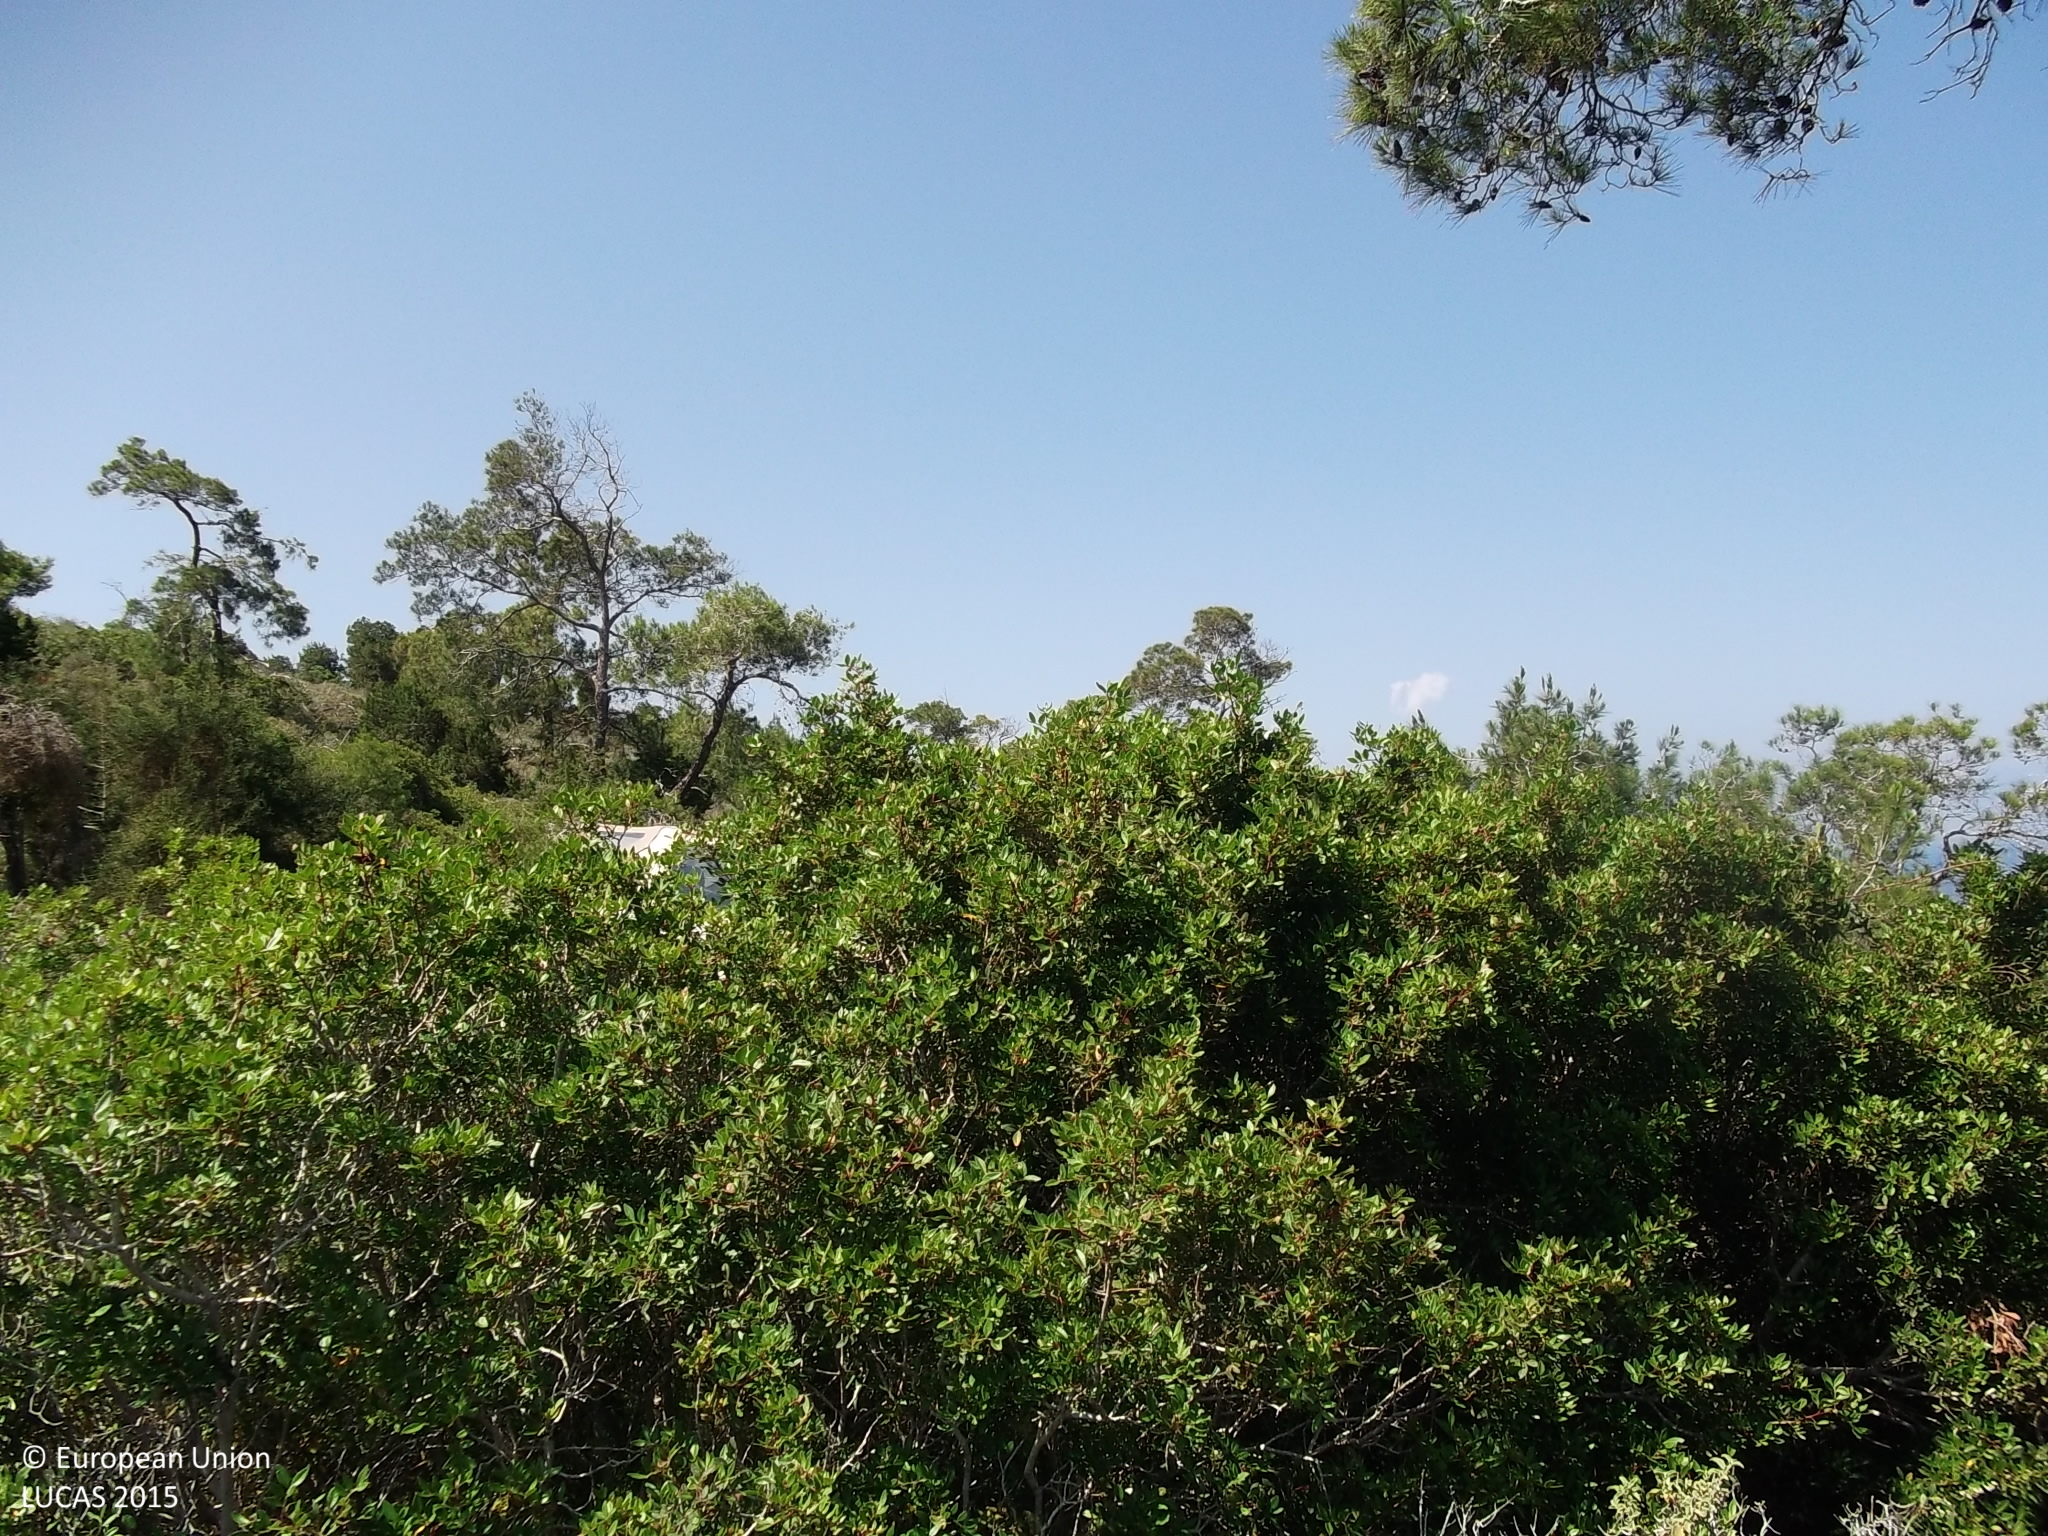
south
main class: Shrubland
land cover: Shrubland with sparse tree cover
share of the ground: > 75 %
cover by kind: shrubs 85 %, unconsolidated bare surface 10 %, broadleaved forest trees 5 %
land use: Agriculture (excluding fallow land and kitchen gardens)
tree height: < 5 m
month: May
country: CY
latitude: 35.0663
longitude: 32.2889
